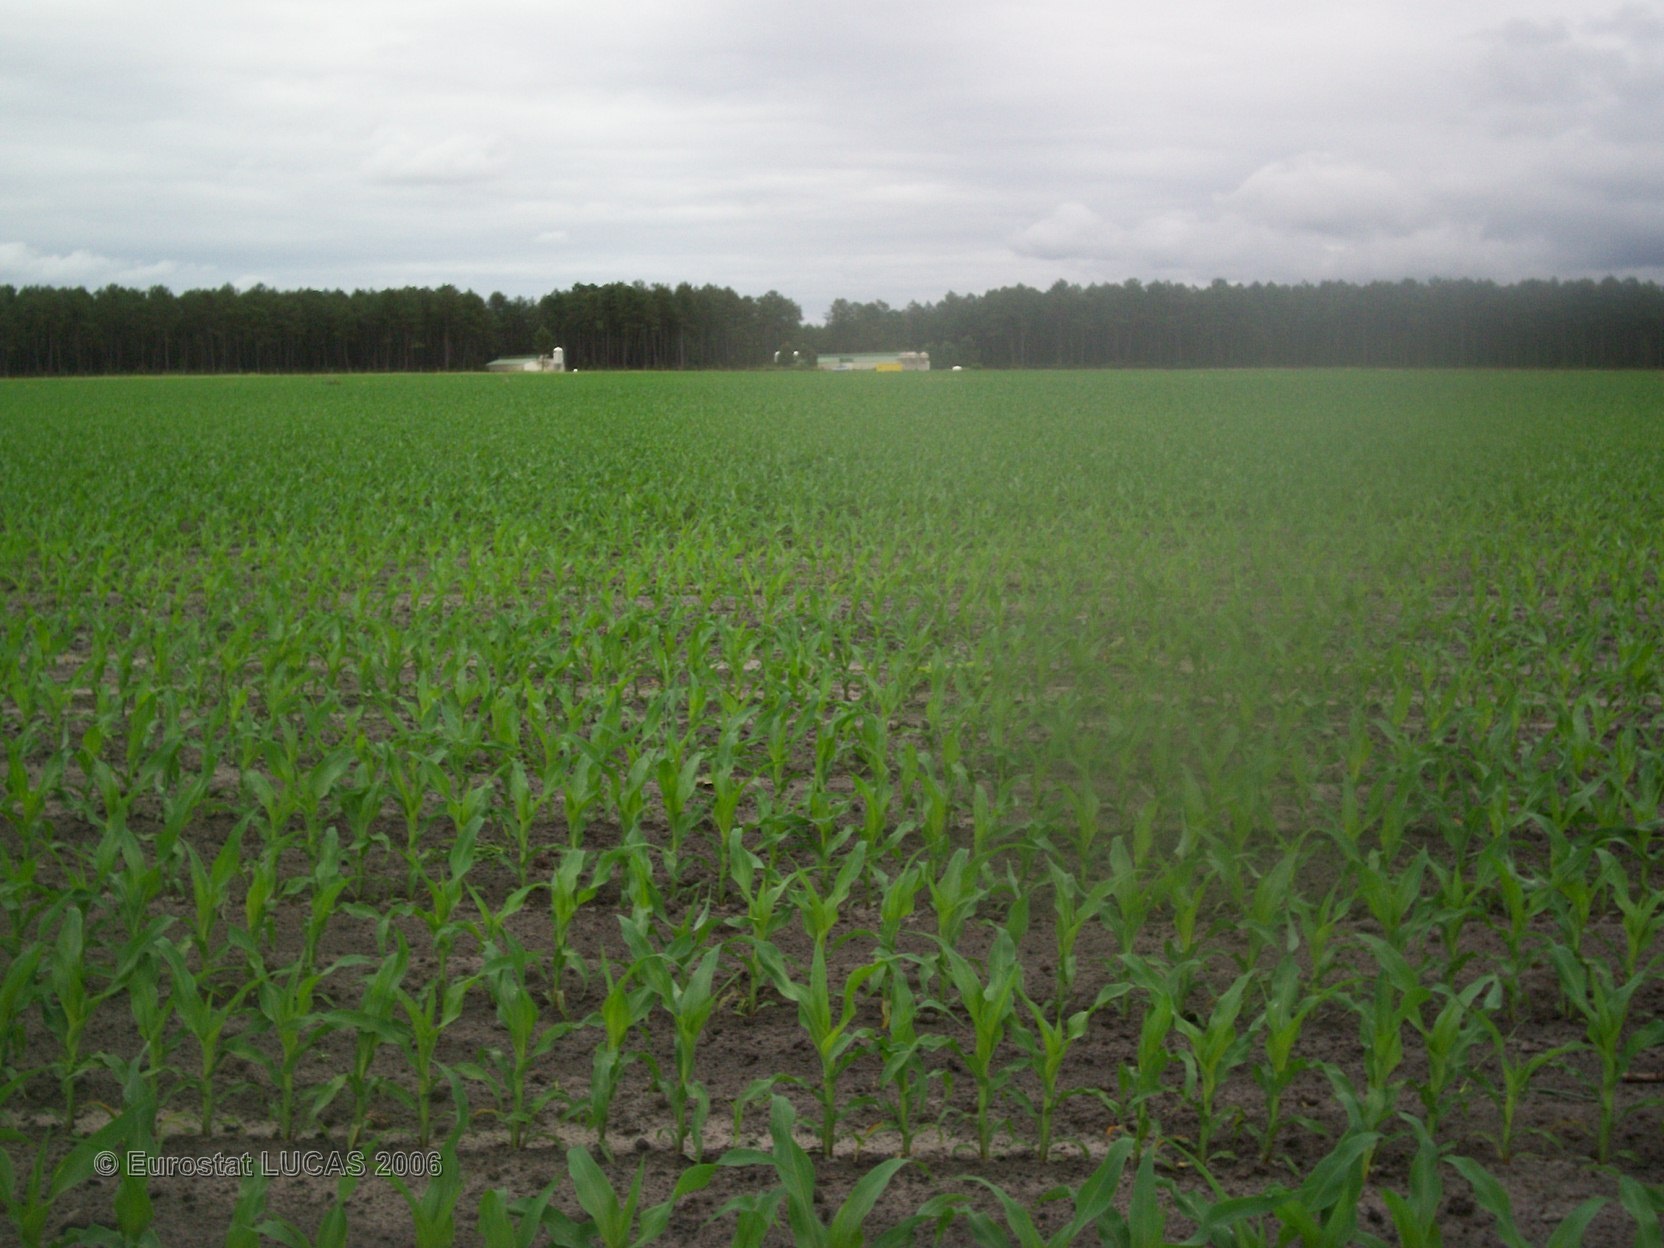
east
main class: Cropland
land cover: Maize
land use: Agriculture (excluding fallow land and kitchen gardens)
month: May
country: FR
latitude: 44.1609
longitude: -0.3286
